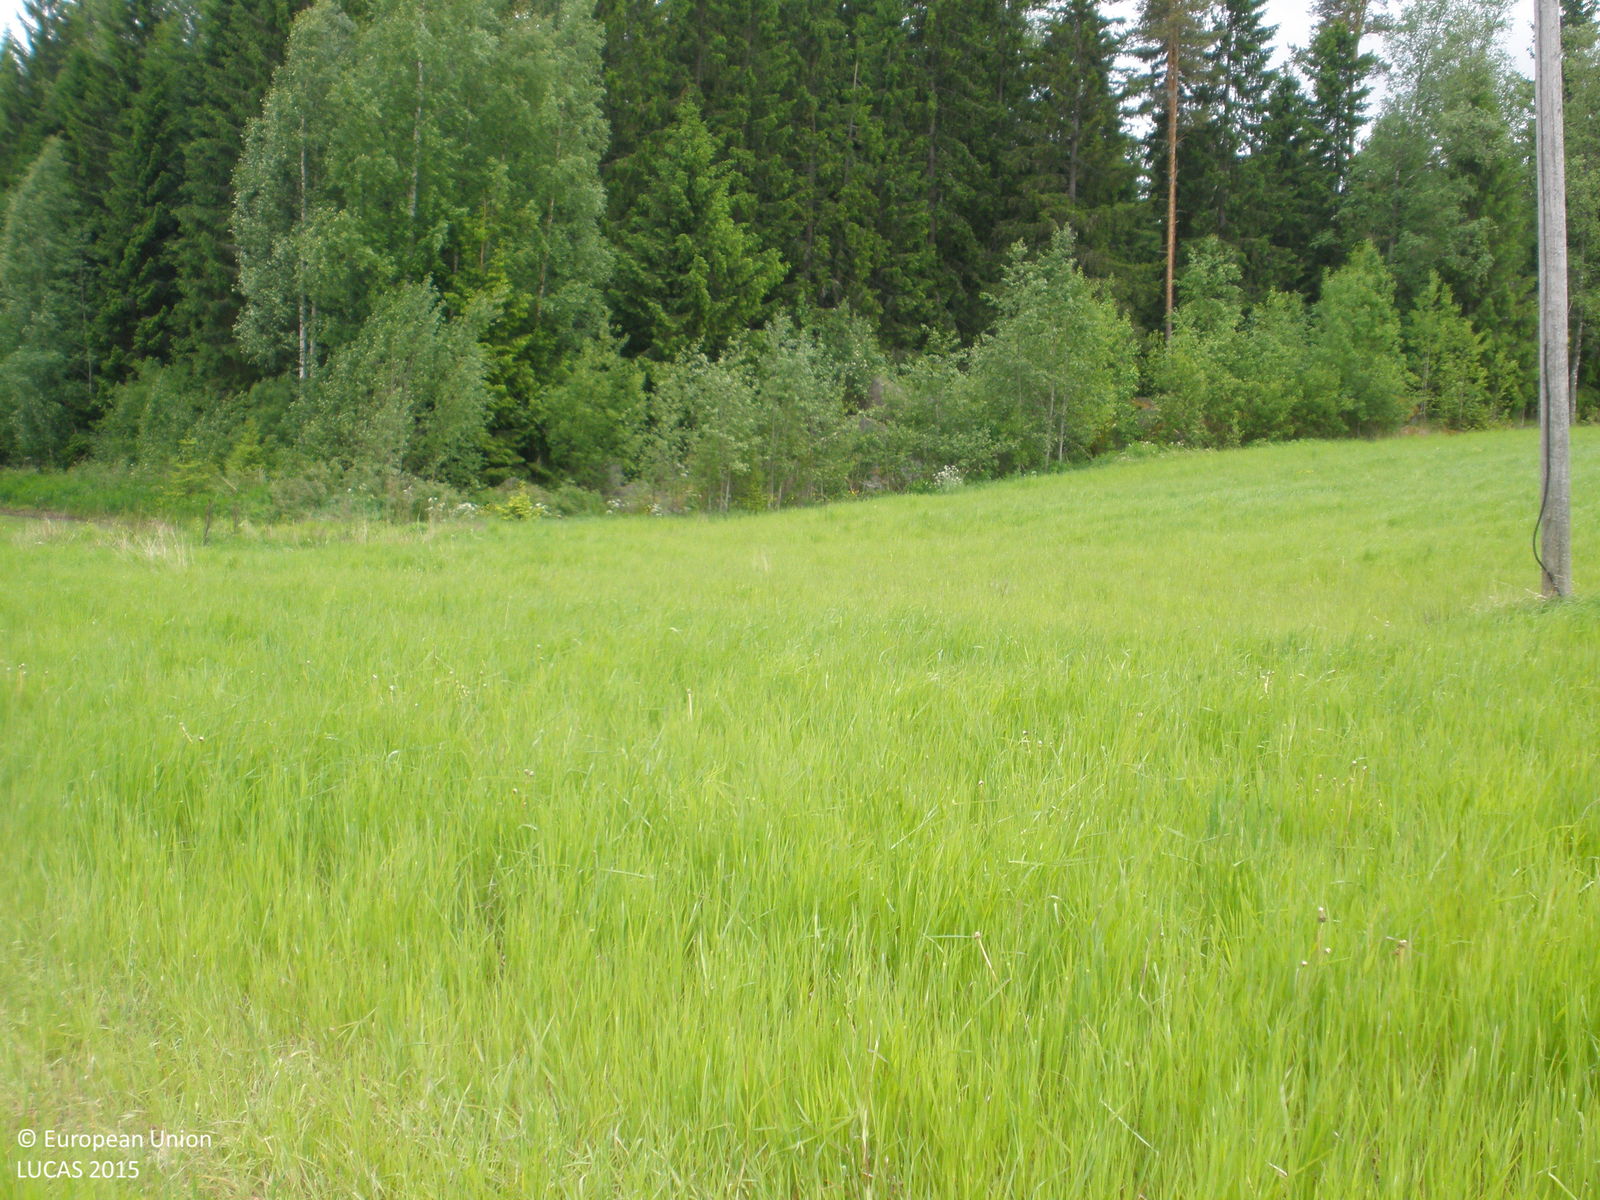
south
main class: Cropland
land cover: Oats
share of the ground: > 75 %
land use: Agriculture (excluding fallow land and kitchen gardens)
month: June
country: FI
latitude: 61.2920
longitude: 24.5649
